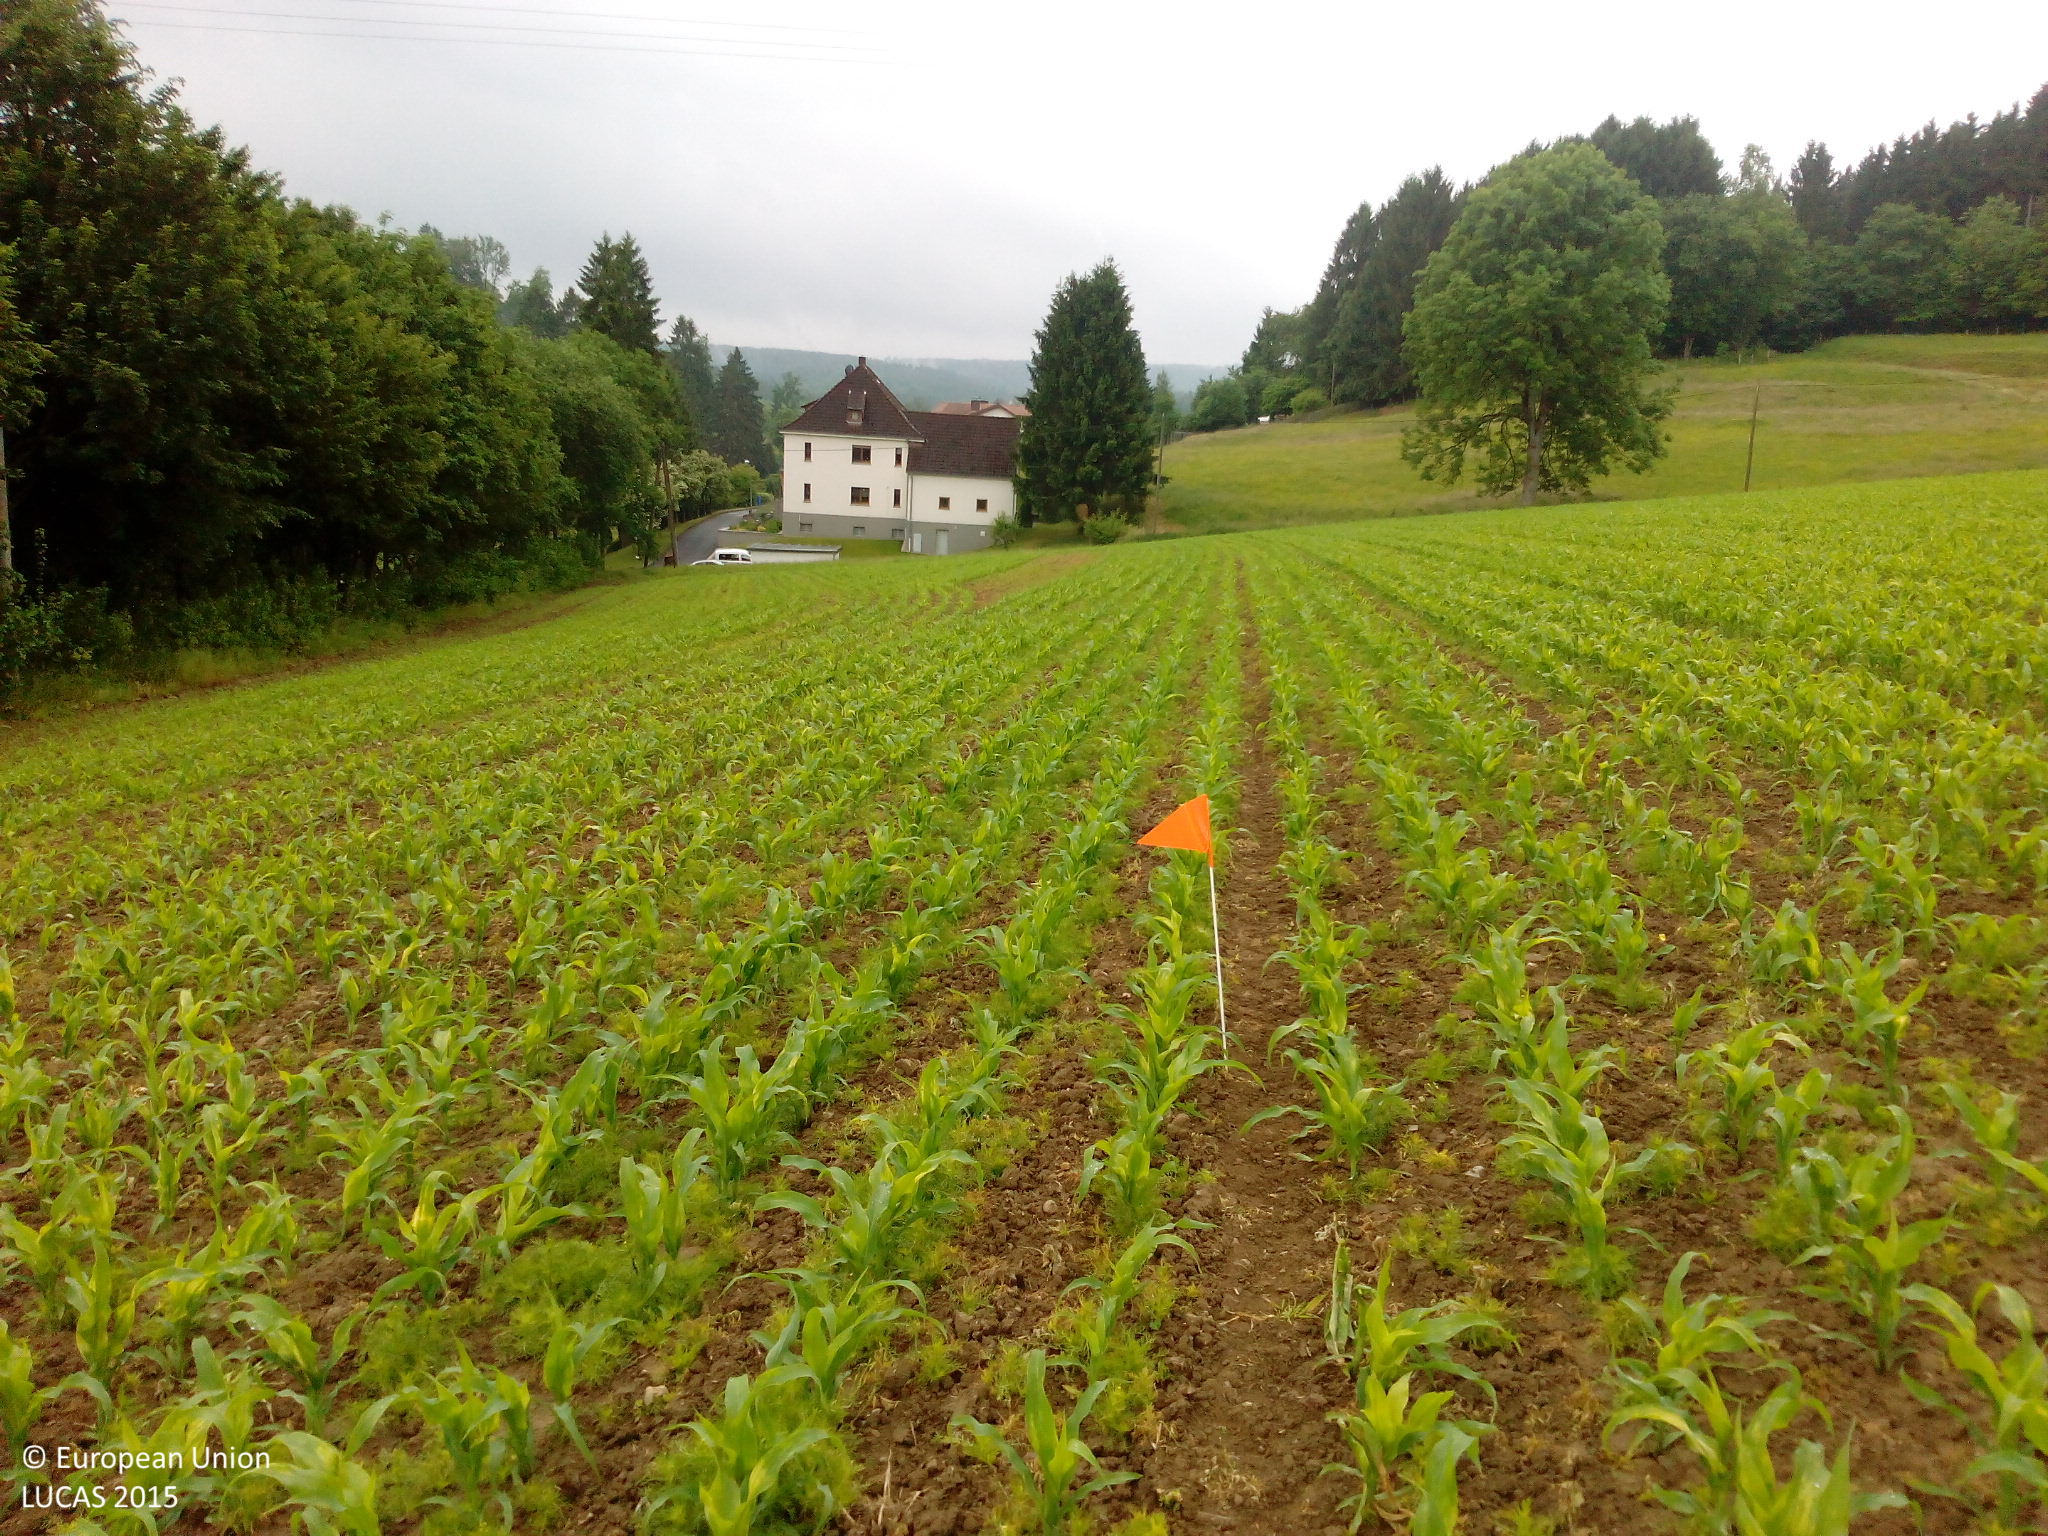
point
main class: Cropland
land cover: Maize
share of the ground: 50 - 75 %
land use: Agriculture (excluding fallow land and kitchen gardens)
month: June
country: DE
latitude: 51.5060
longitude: 8.5740
